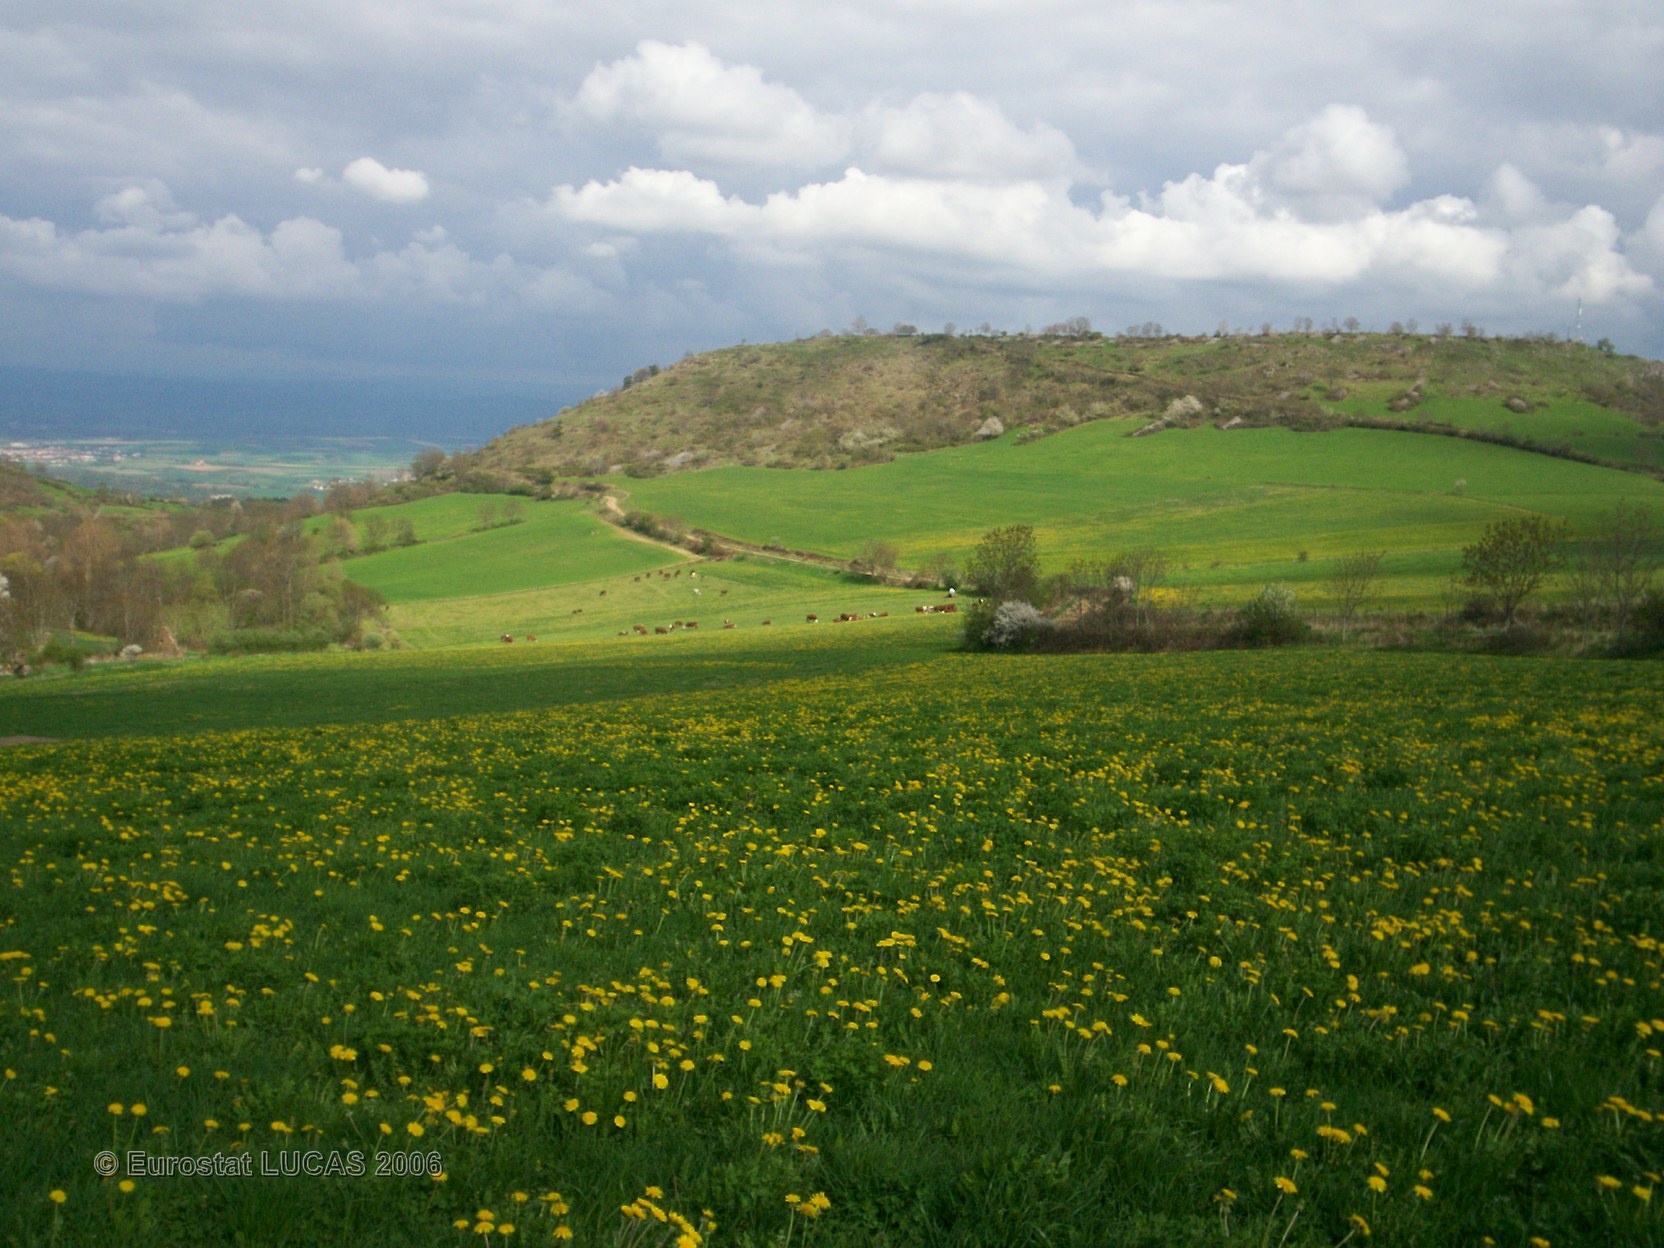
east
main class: Grassland
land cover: Grassland without tree/shrub cover
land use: Agriculture (excluding fallow land and kitchen gardens)
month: April
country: FR
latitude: 45.4257
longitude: 3.1377
